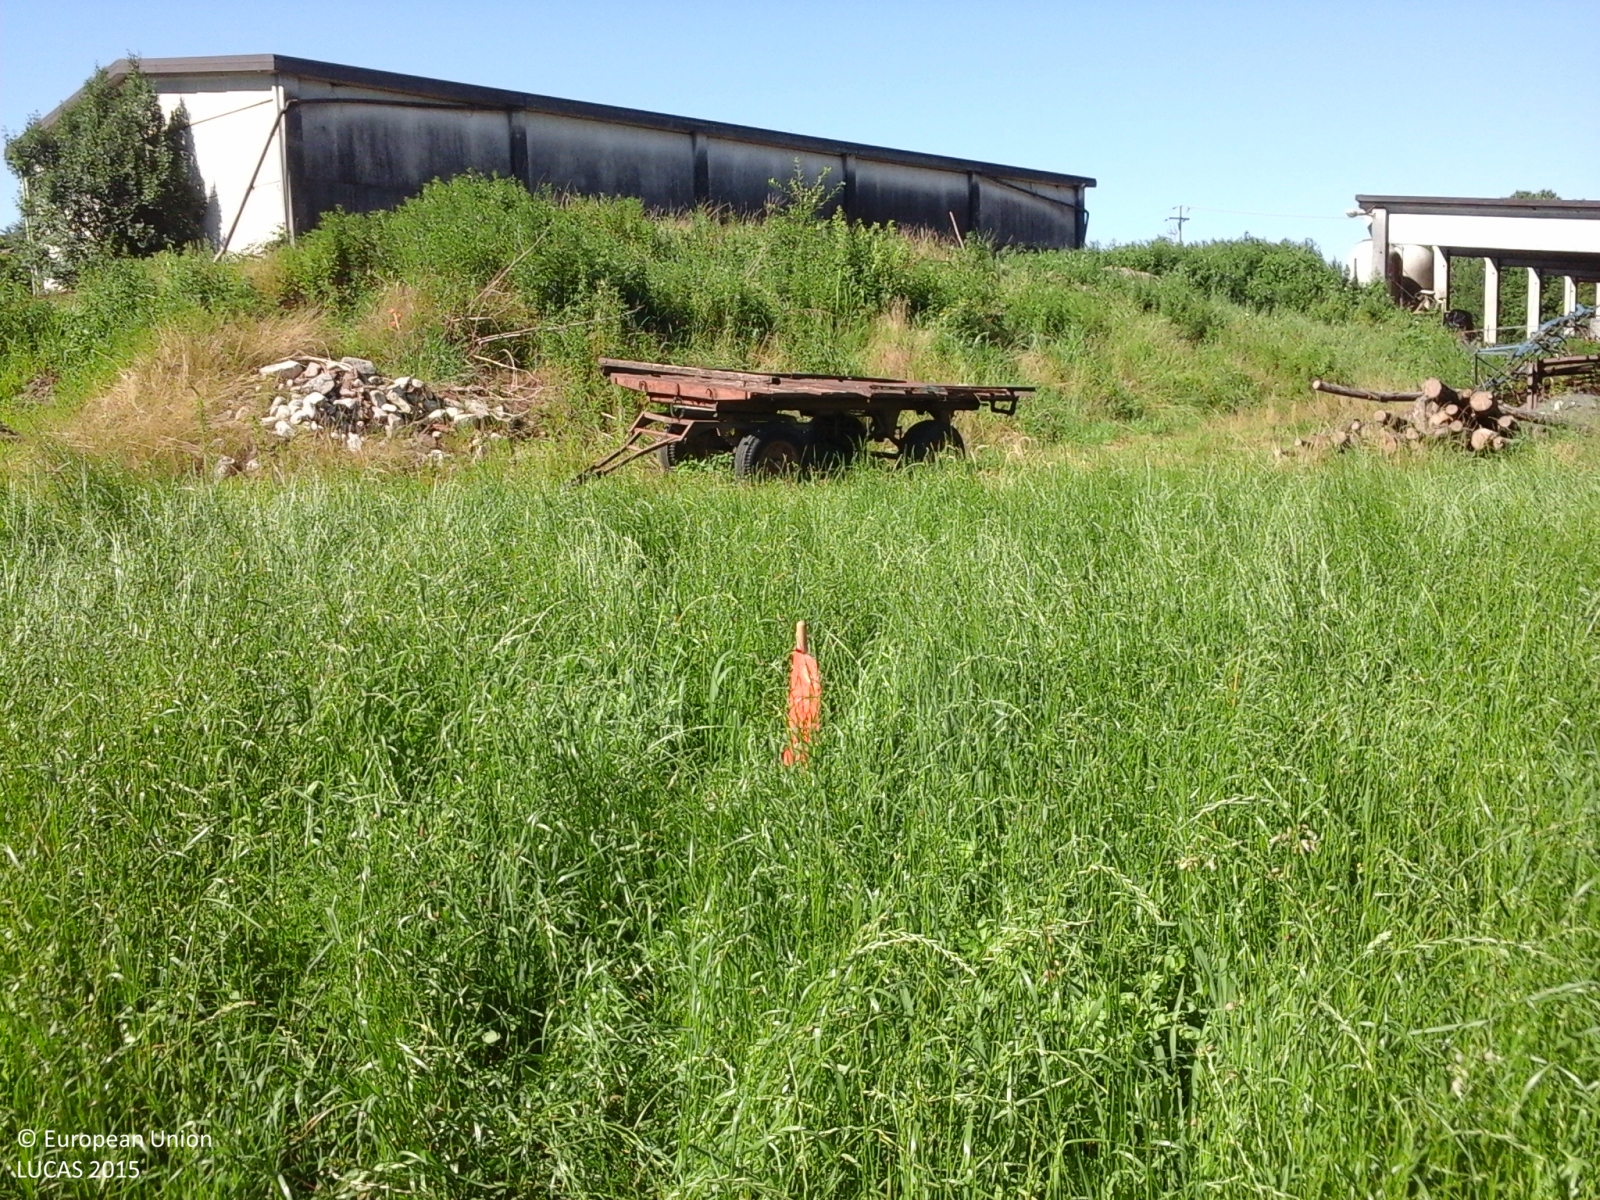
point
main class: Grassland
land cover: Grassland without tree/shrub cover
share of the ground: > 75 %
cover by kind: herbaceous plants 100 %
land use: Agriculture (excluding fallow land and kitchen gardens)
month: June
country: IT
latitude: 45.7838
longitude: 8.6258
